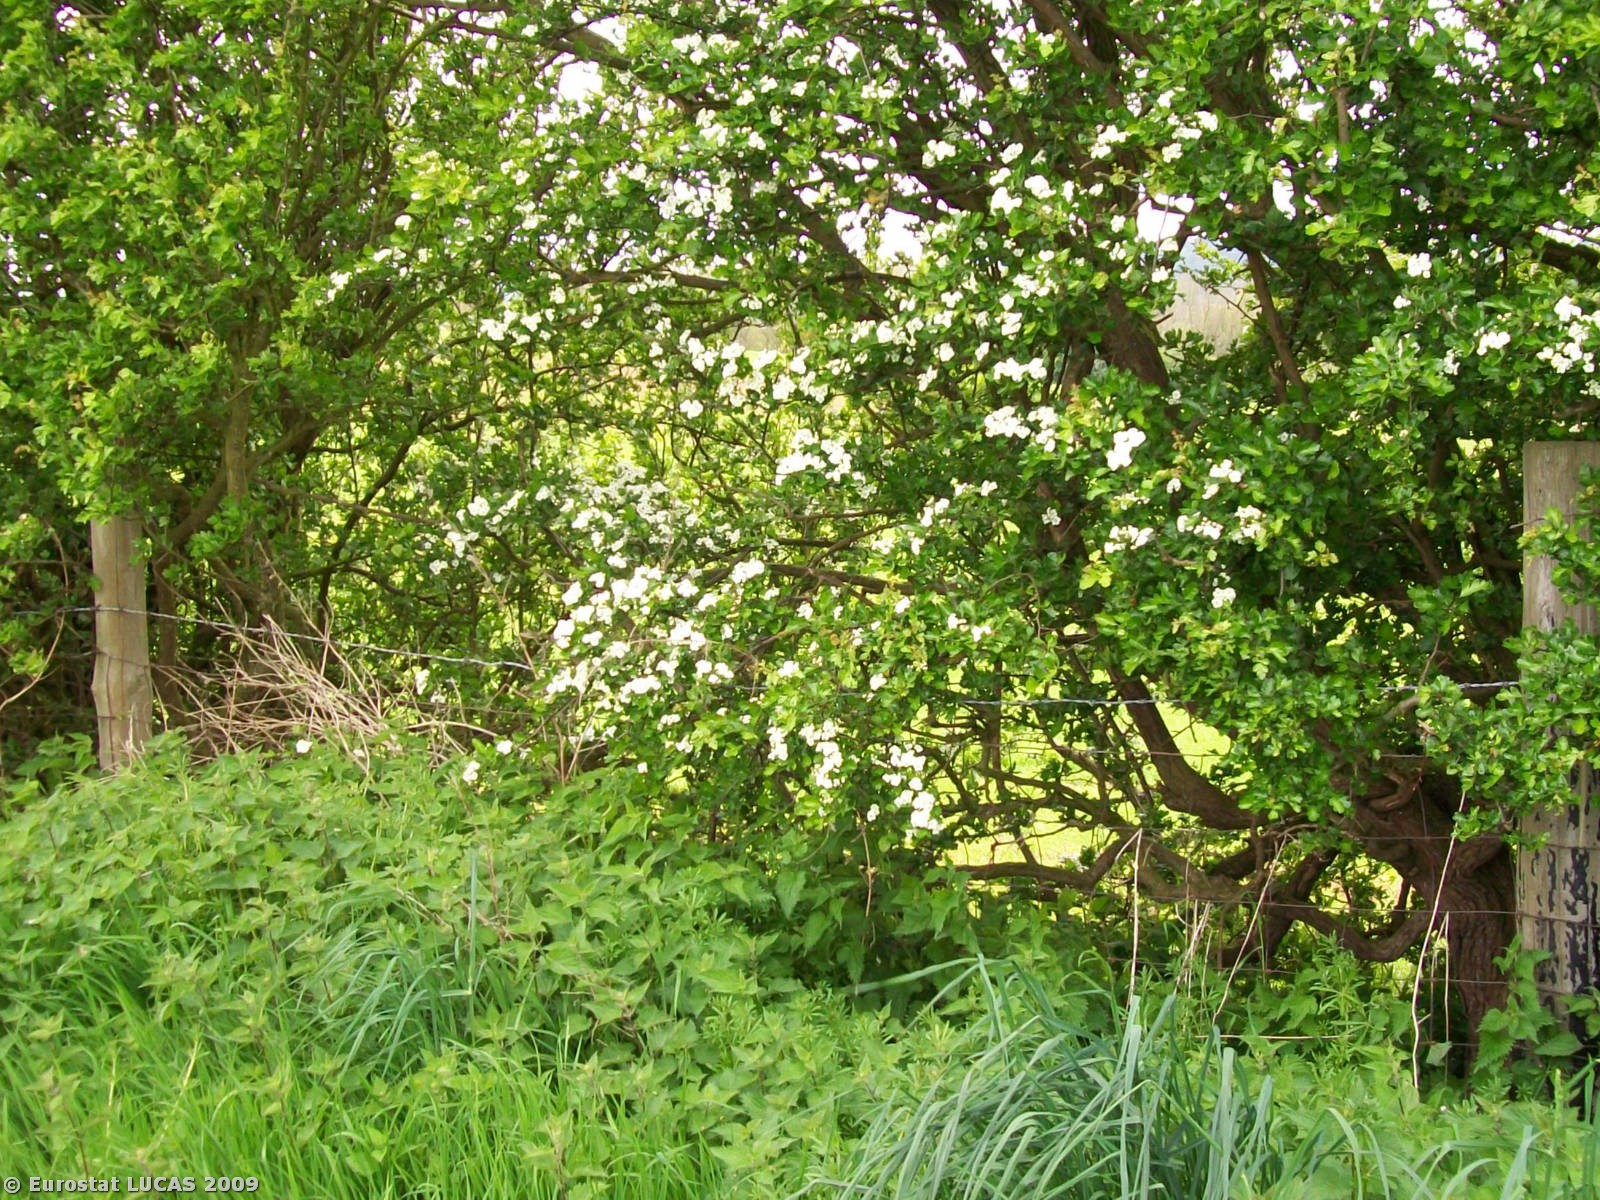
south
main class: Cropland
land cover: Oats
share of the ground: > 75 %
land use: Agriculture (excluding fallow land and kitchen gardens)
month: May
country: GB
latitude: 52.3036
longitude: -2.4281
